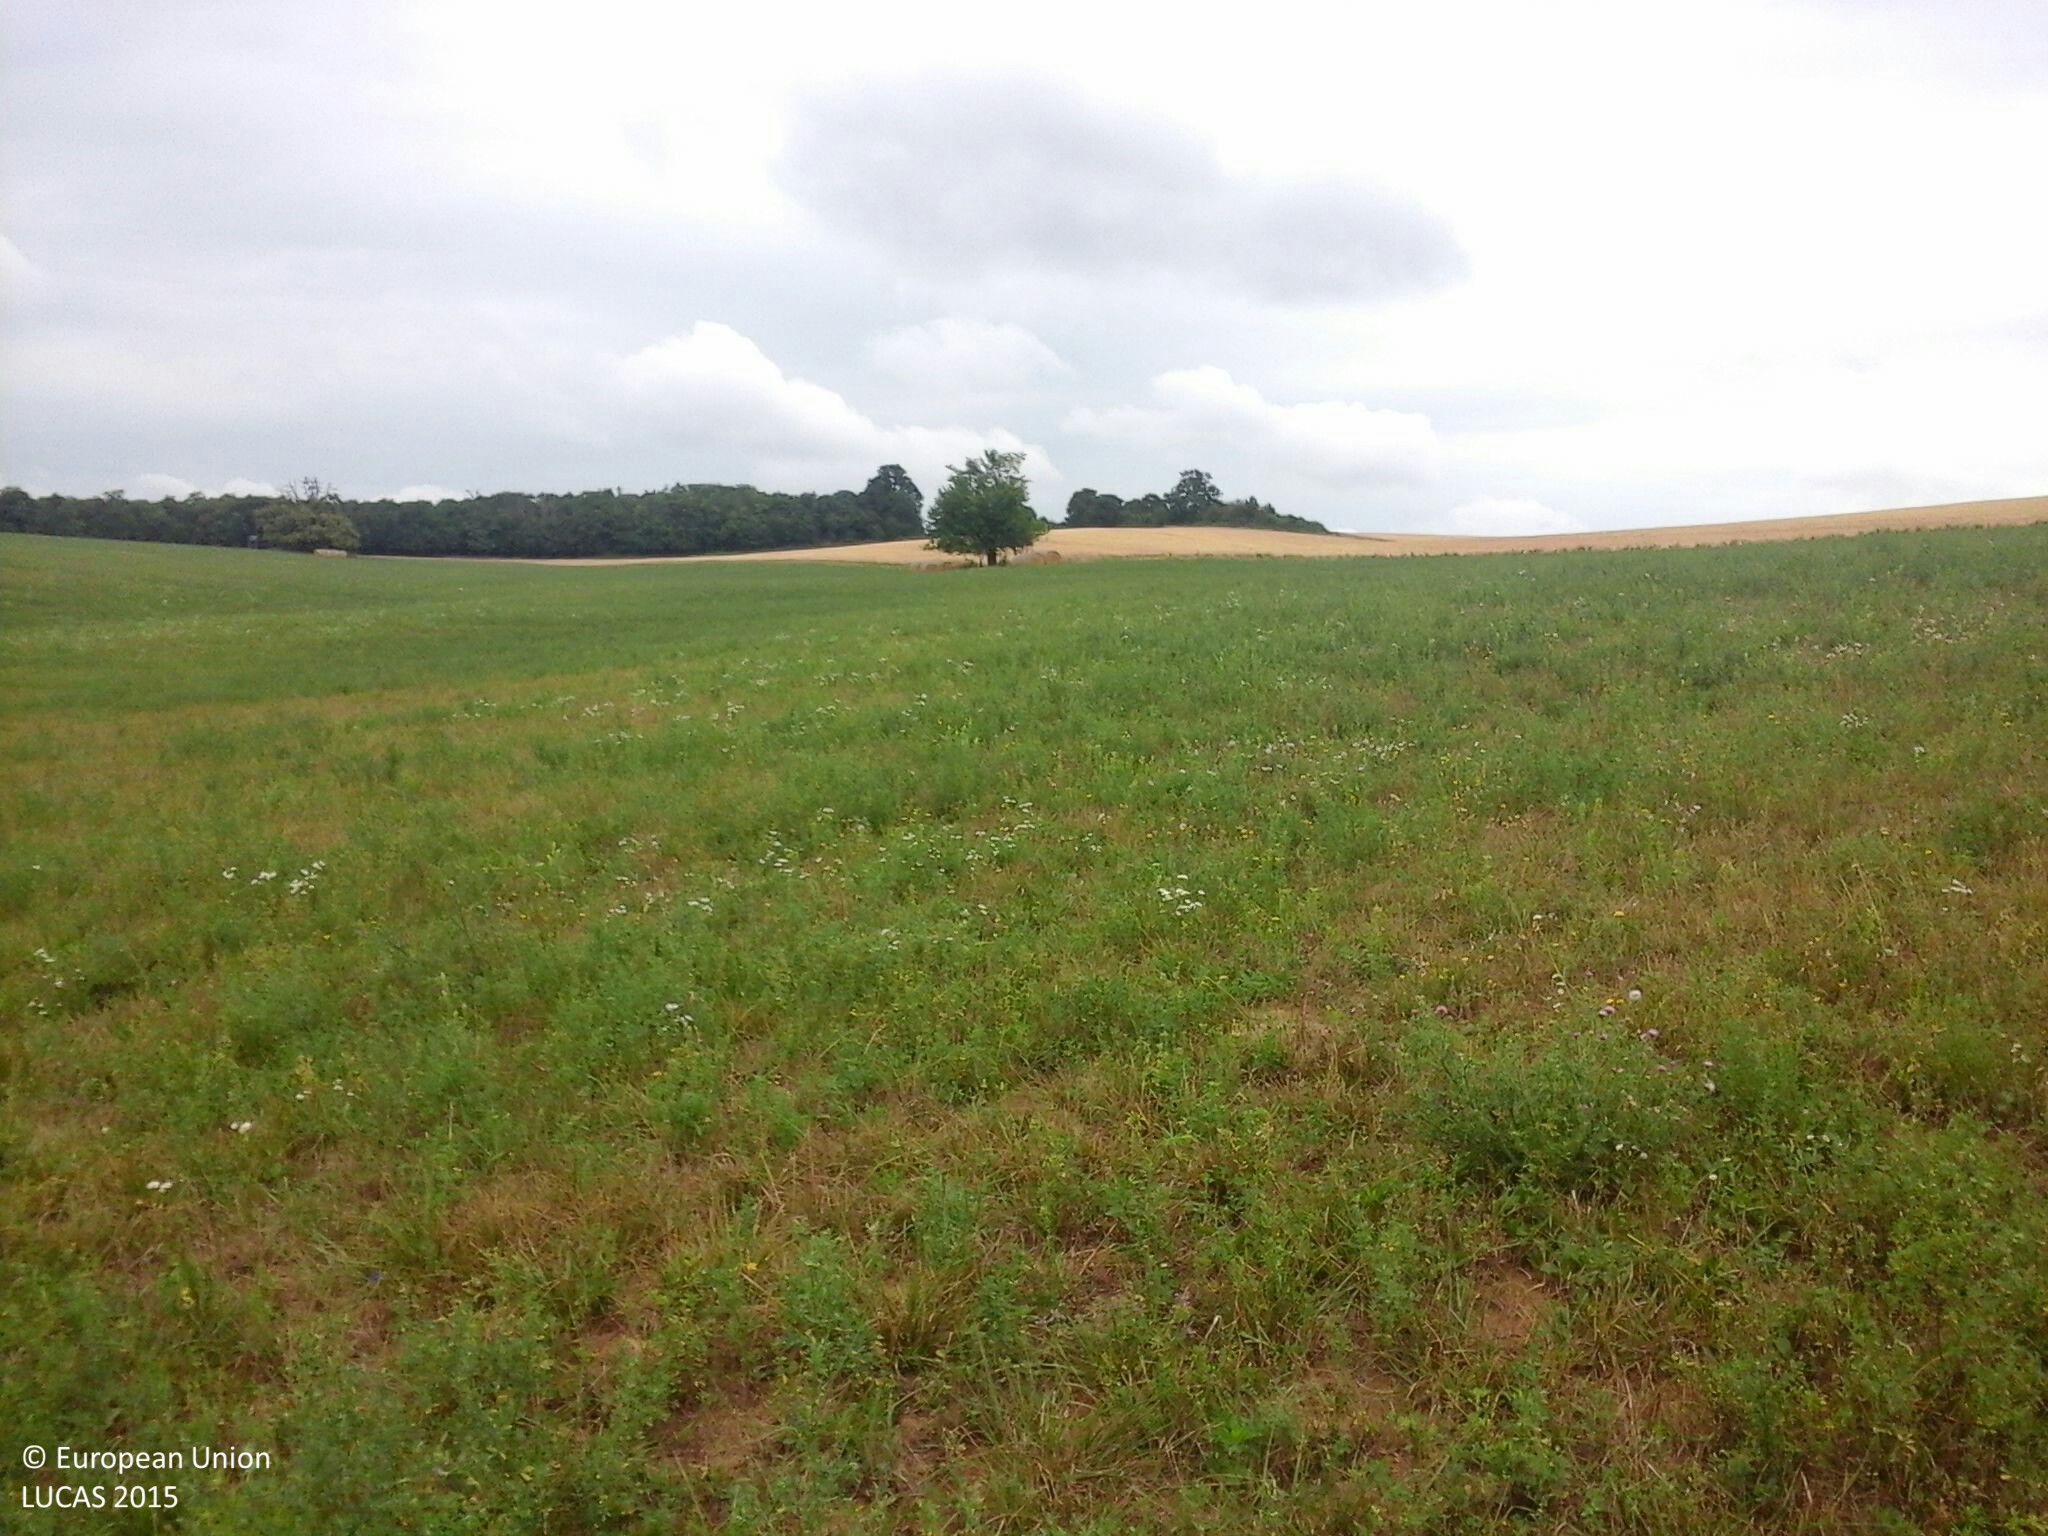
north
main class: Cropland
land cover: Lucerne
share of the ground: > 75 %
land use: Agriculture (excluding fallow land and kitchen gardens)
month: July
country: HU
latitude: 46.7641
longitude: 17.9033
